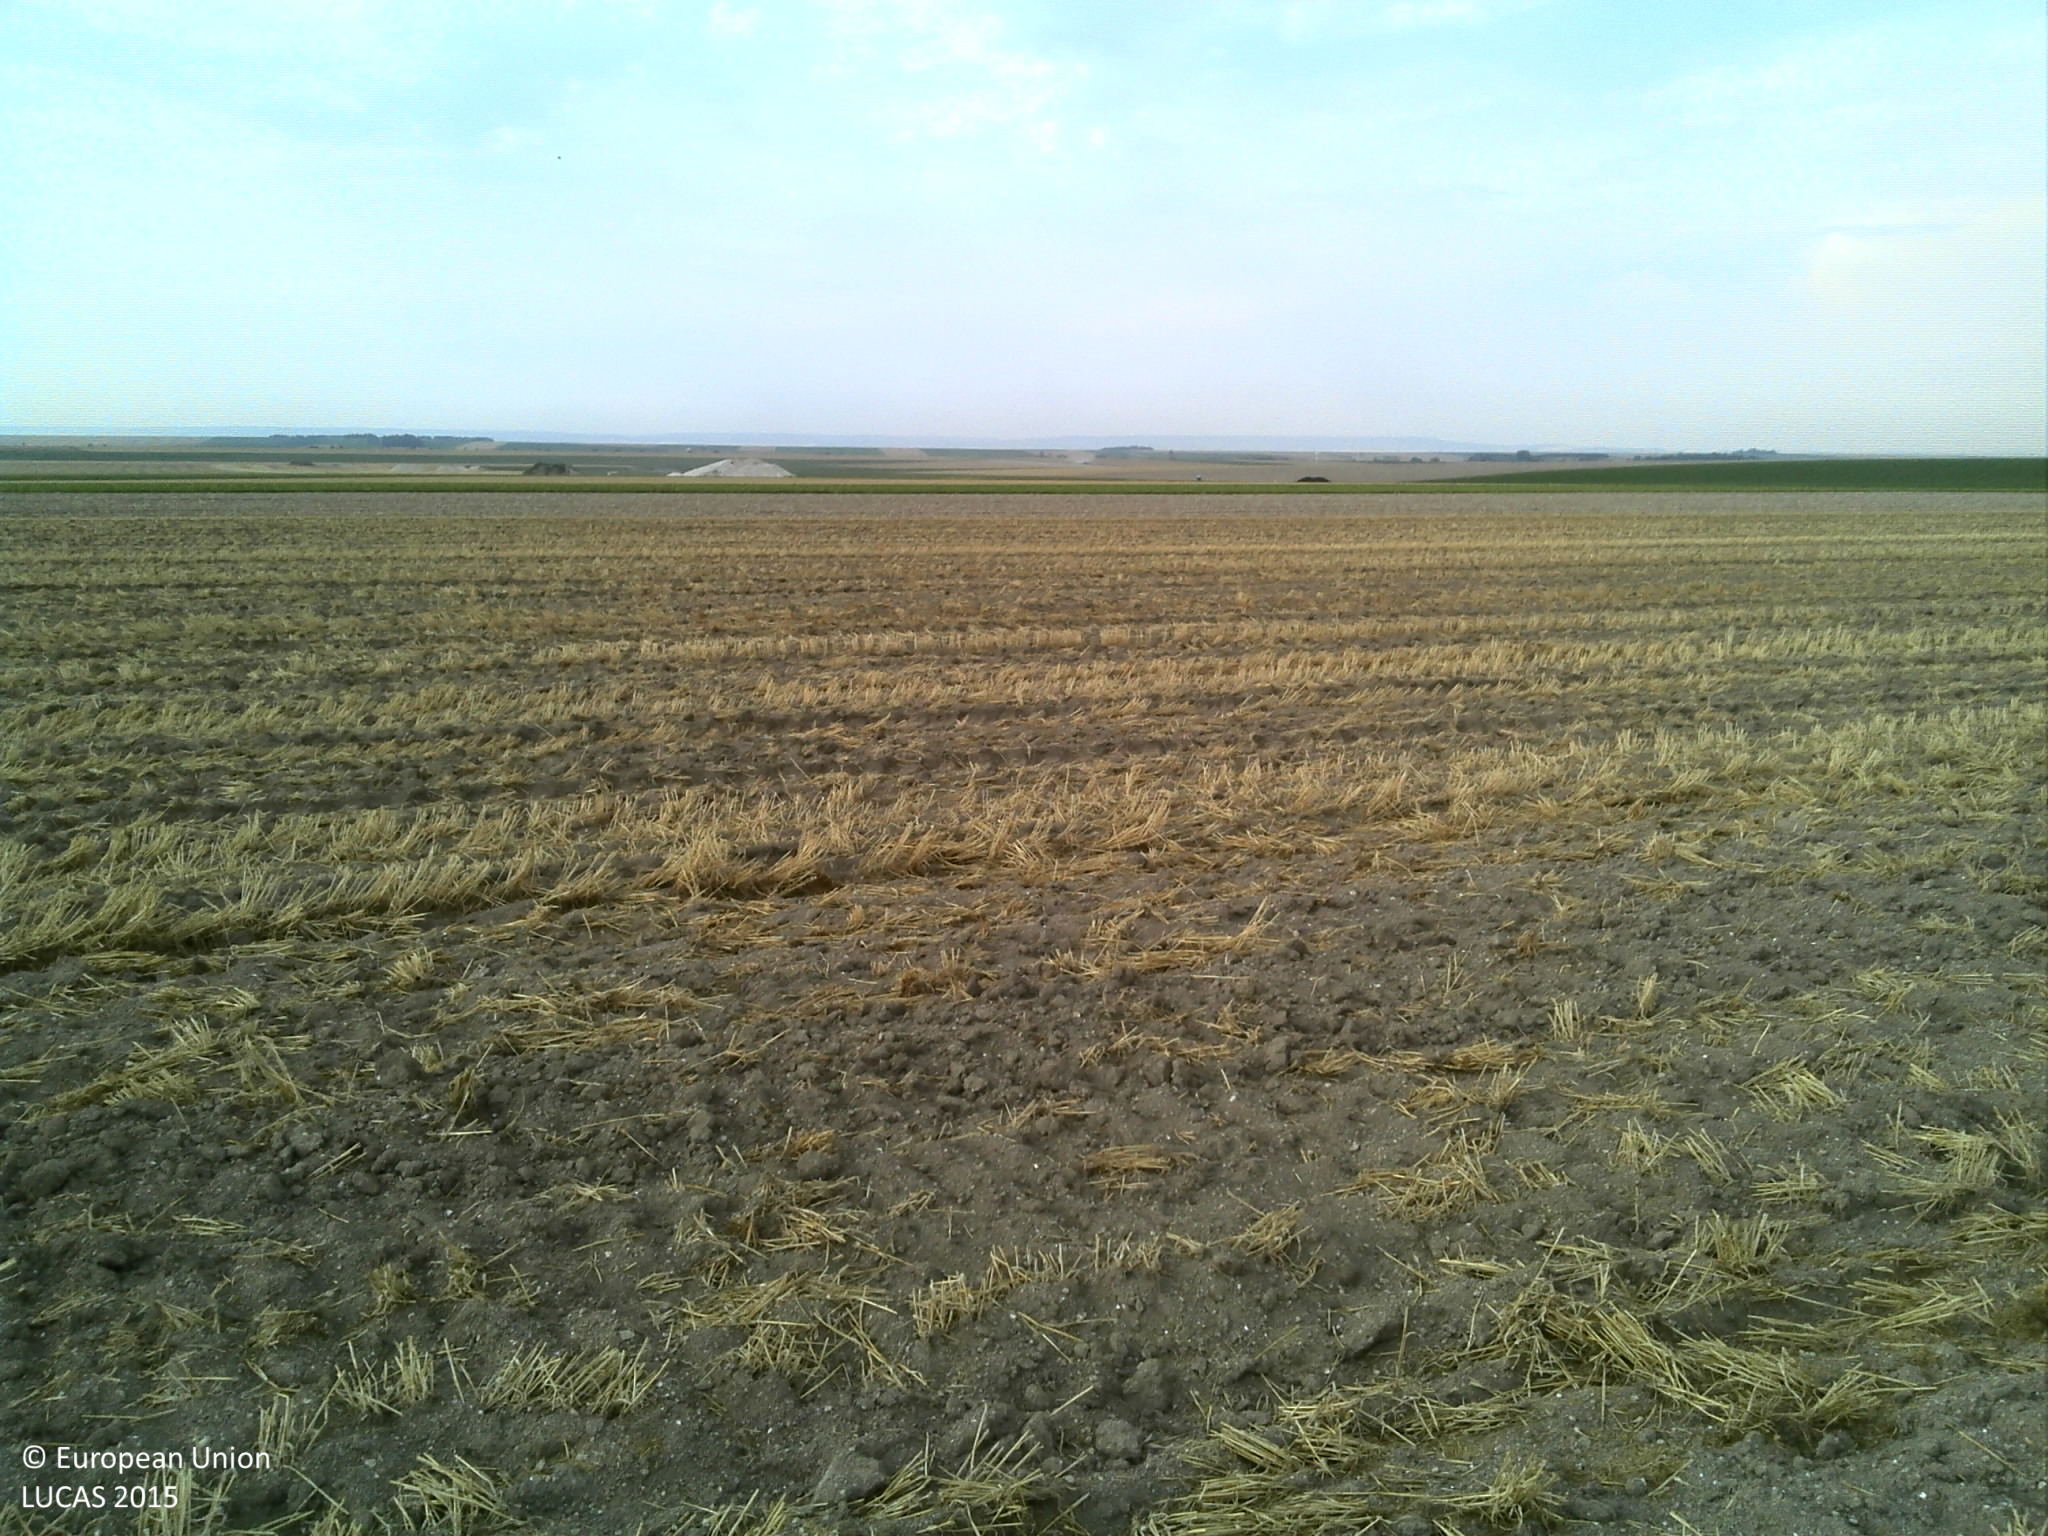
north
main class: Cropland
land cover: Barley
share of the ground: > 75 %
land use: Agriculture (excluding fallow land and kitchen gardens)
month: August
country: FR
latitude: 48.9019
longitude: 4.2254
